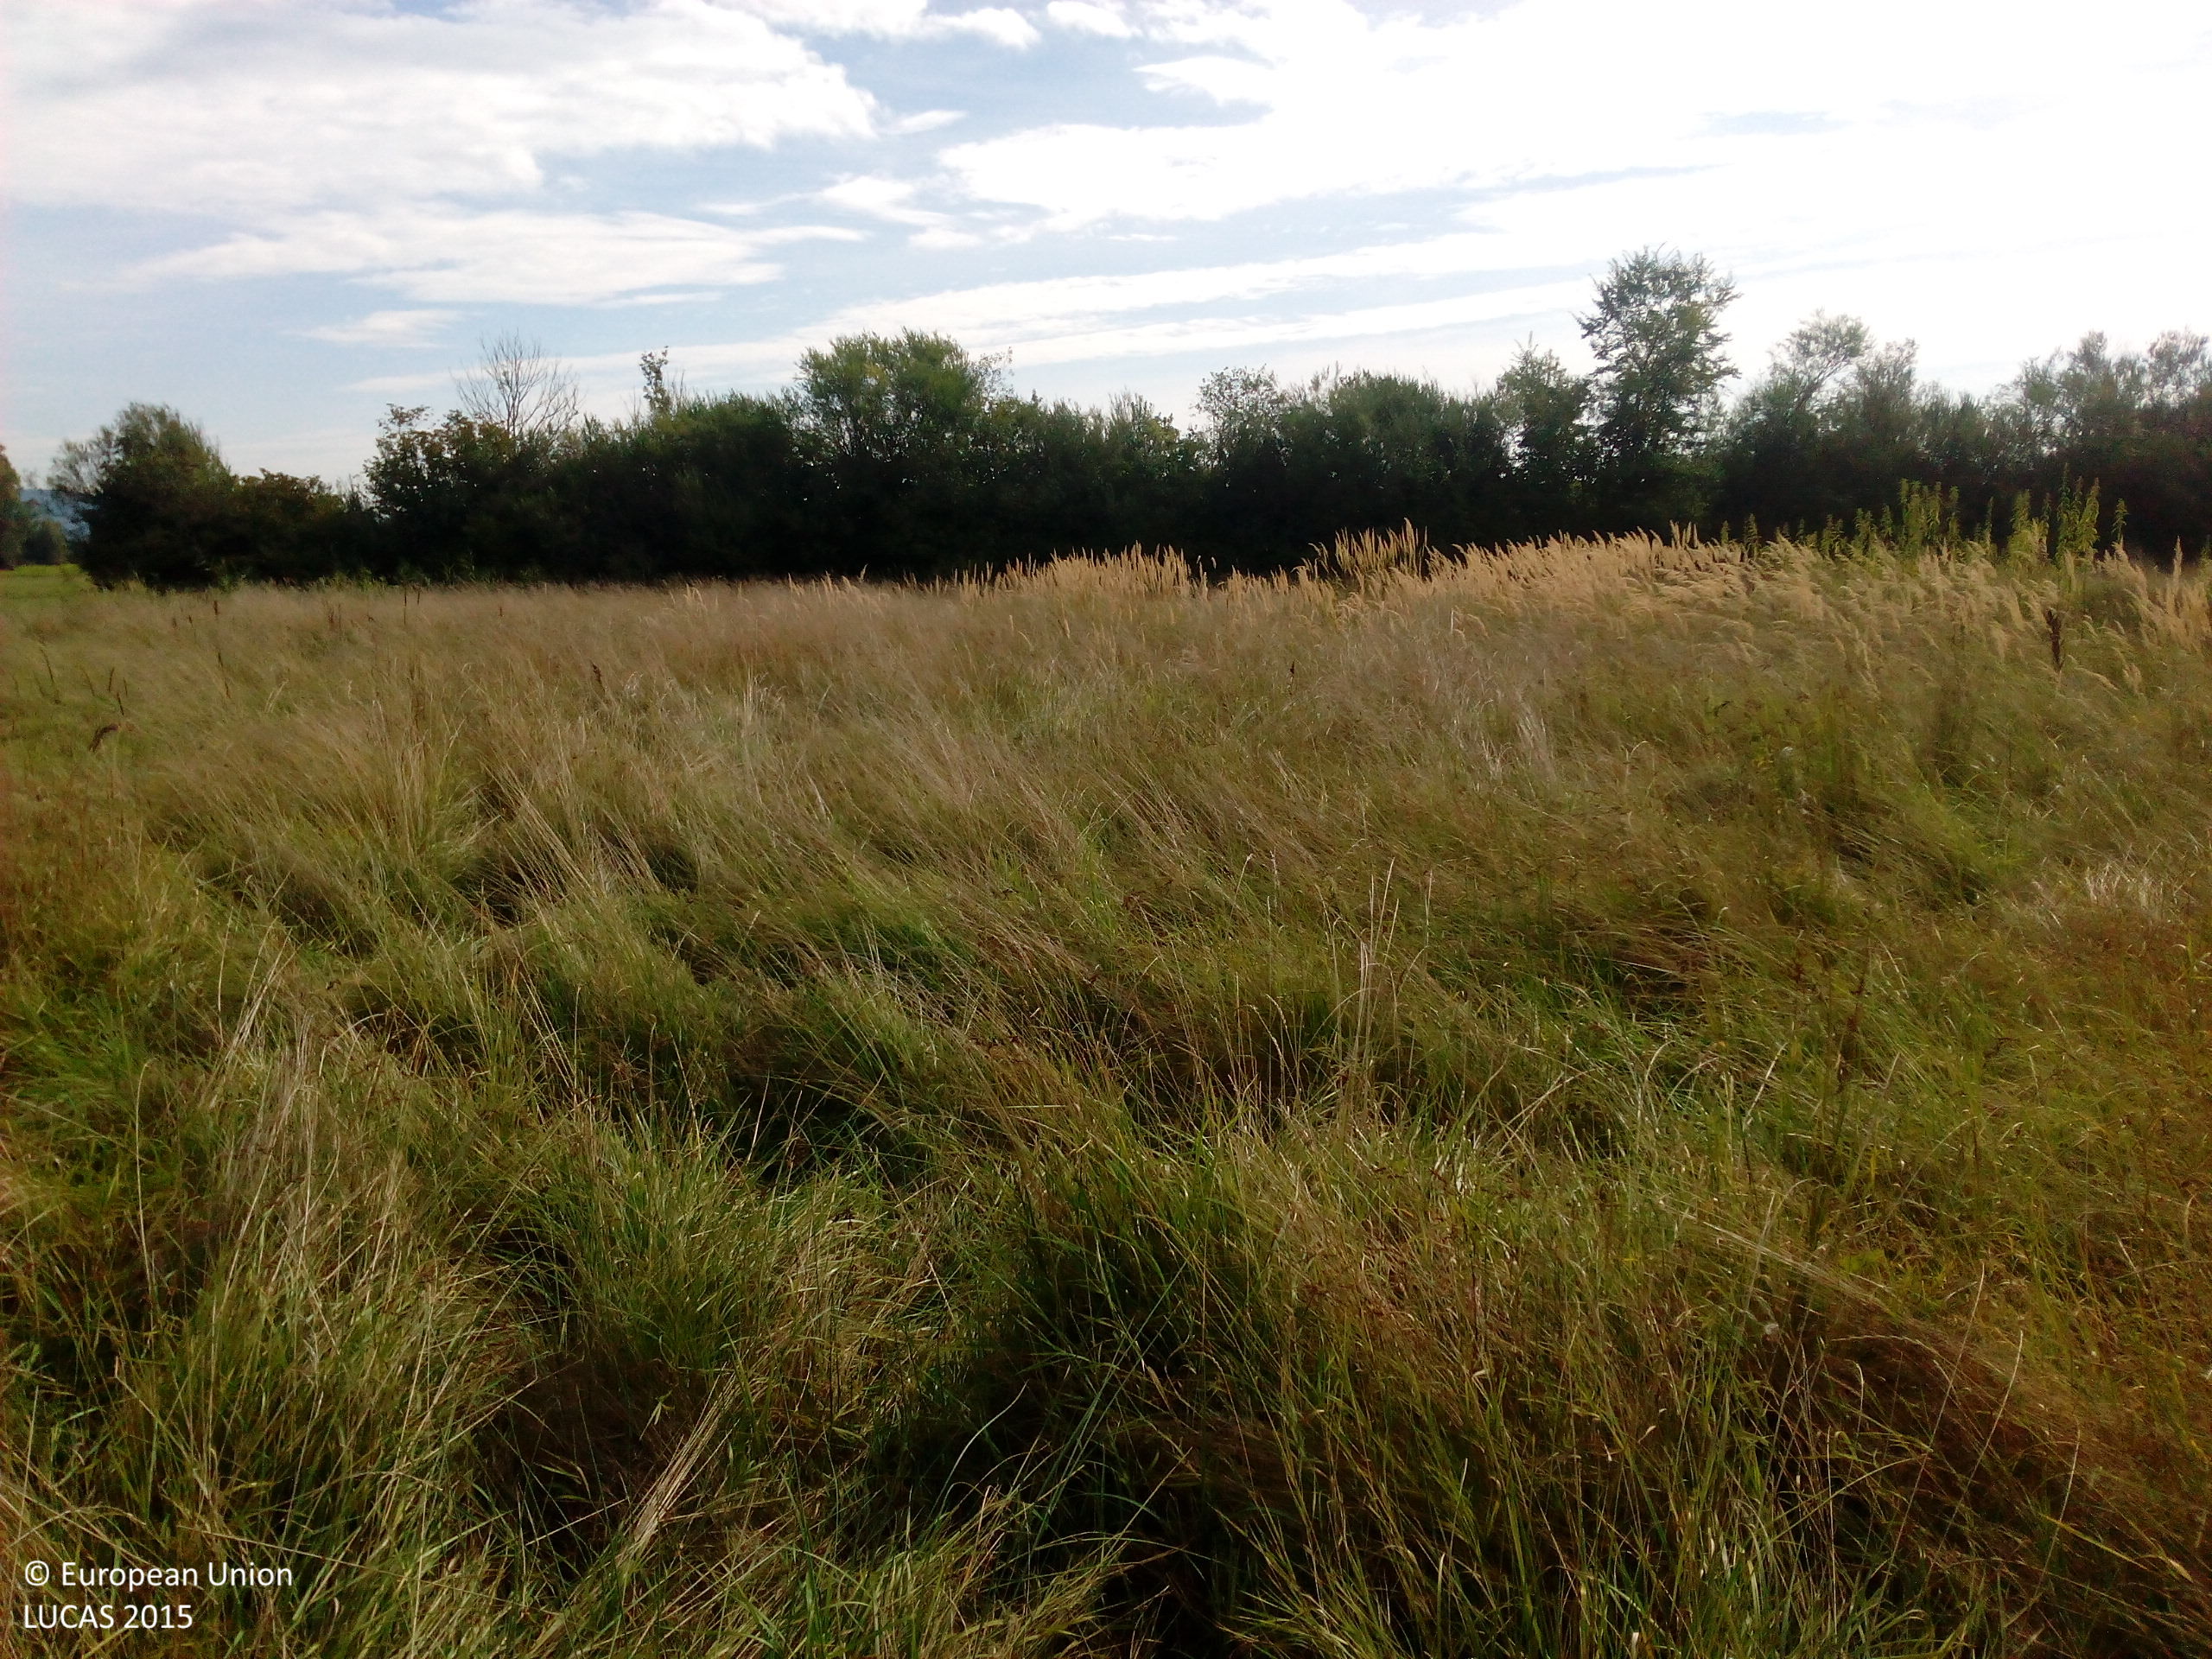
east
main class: Grassland
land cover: Grassland without tree/shrub cover
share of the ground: > 75 %
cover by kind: herbaceous plants 100 %
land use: Agriculture (excluding fallow land and kitchen gardens)
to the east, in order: Grassland without tree/shrub cover; Broadleaved woodland; Fences; Grassland without tree/shrub cover
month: August
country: DE
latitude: 48.7782
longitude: 12.9525
